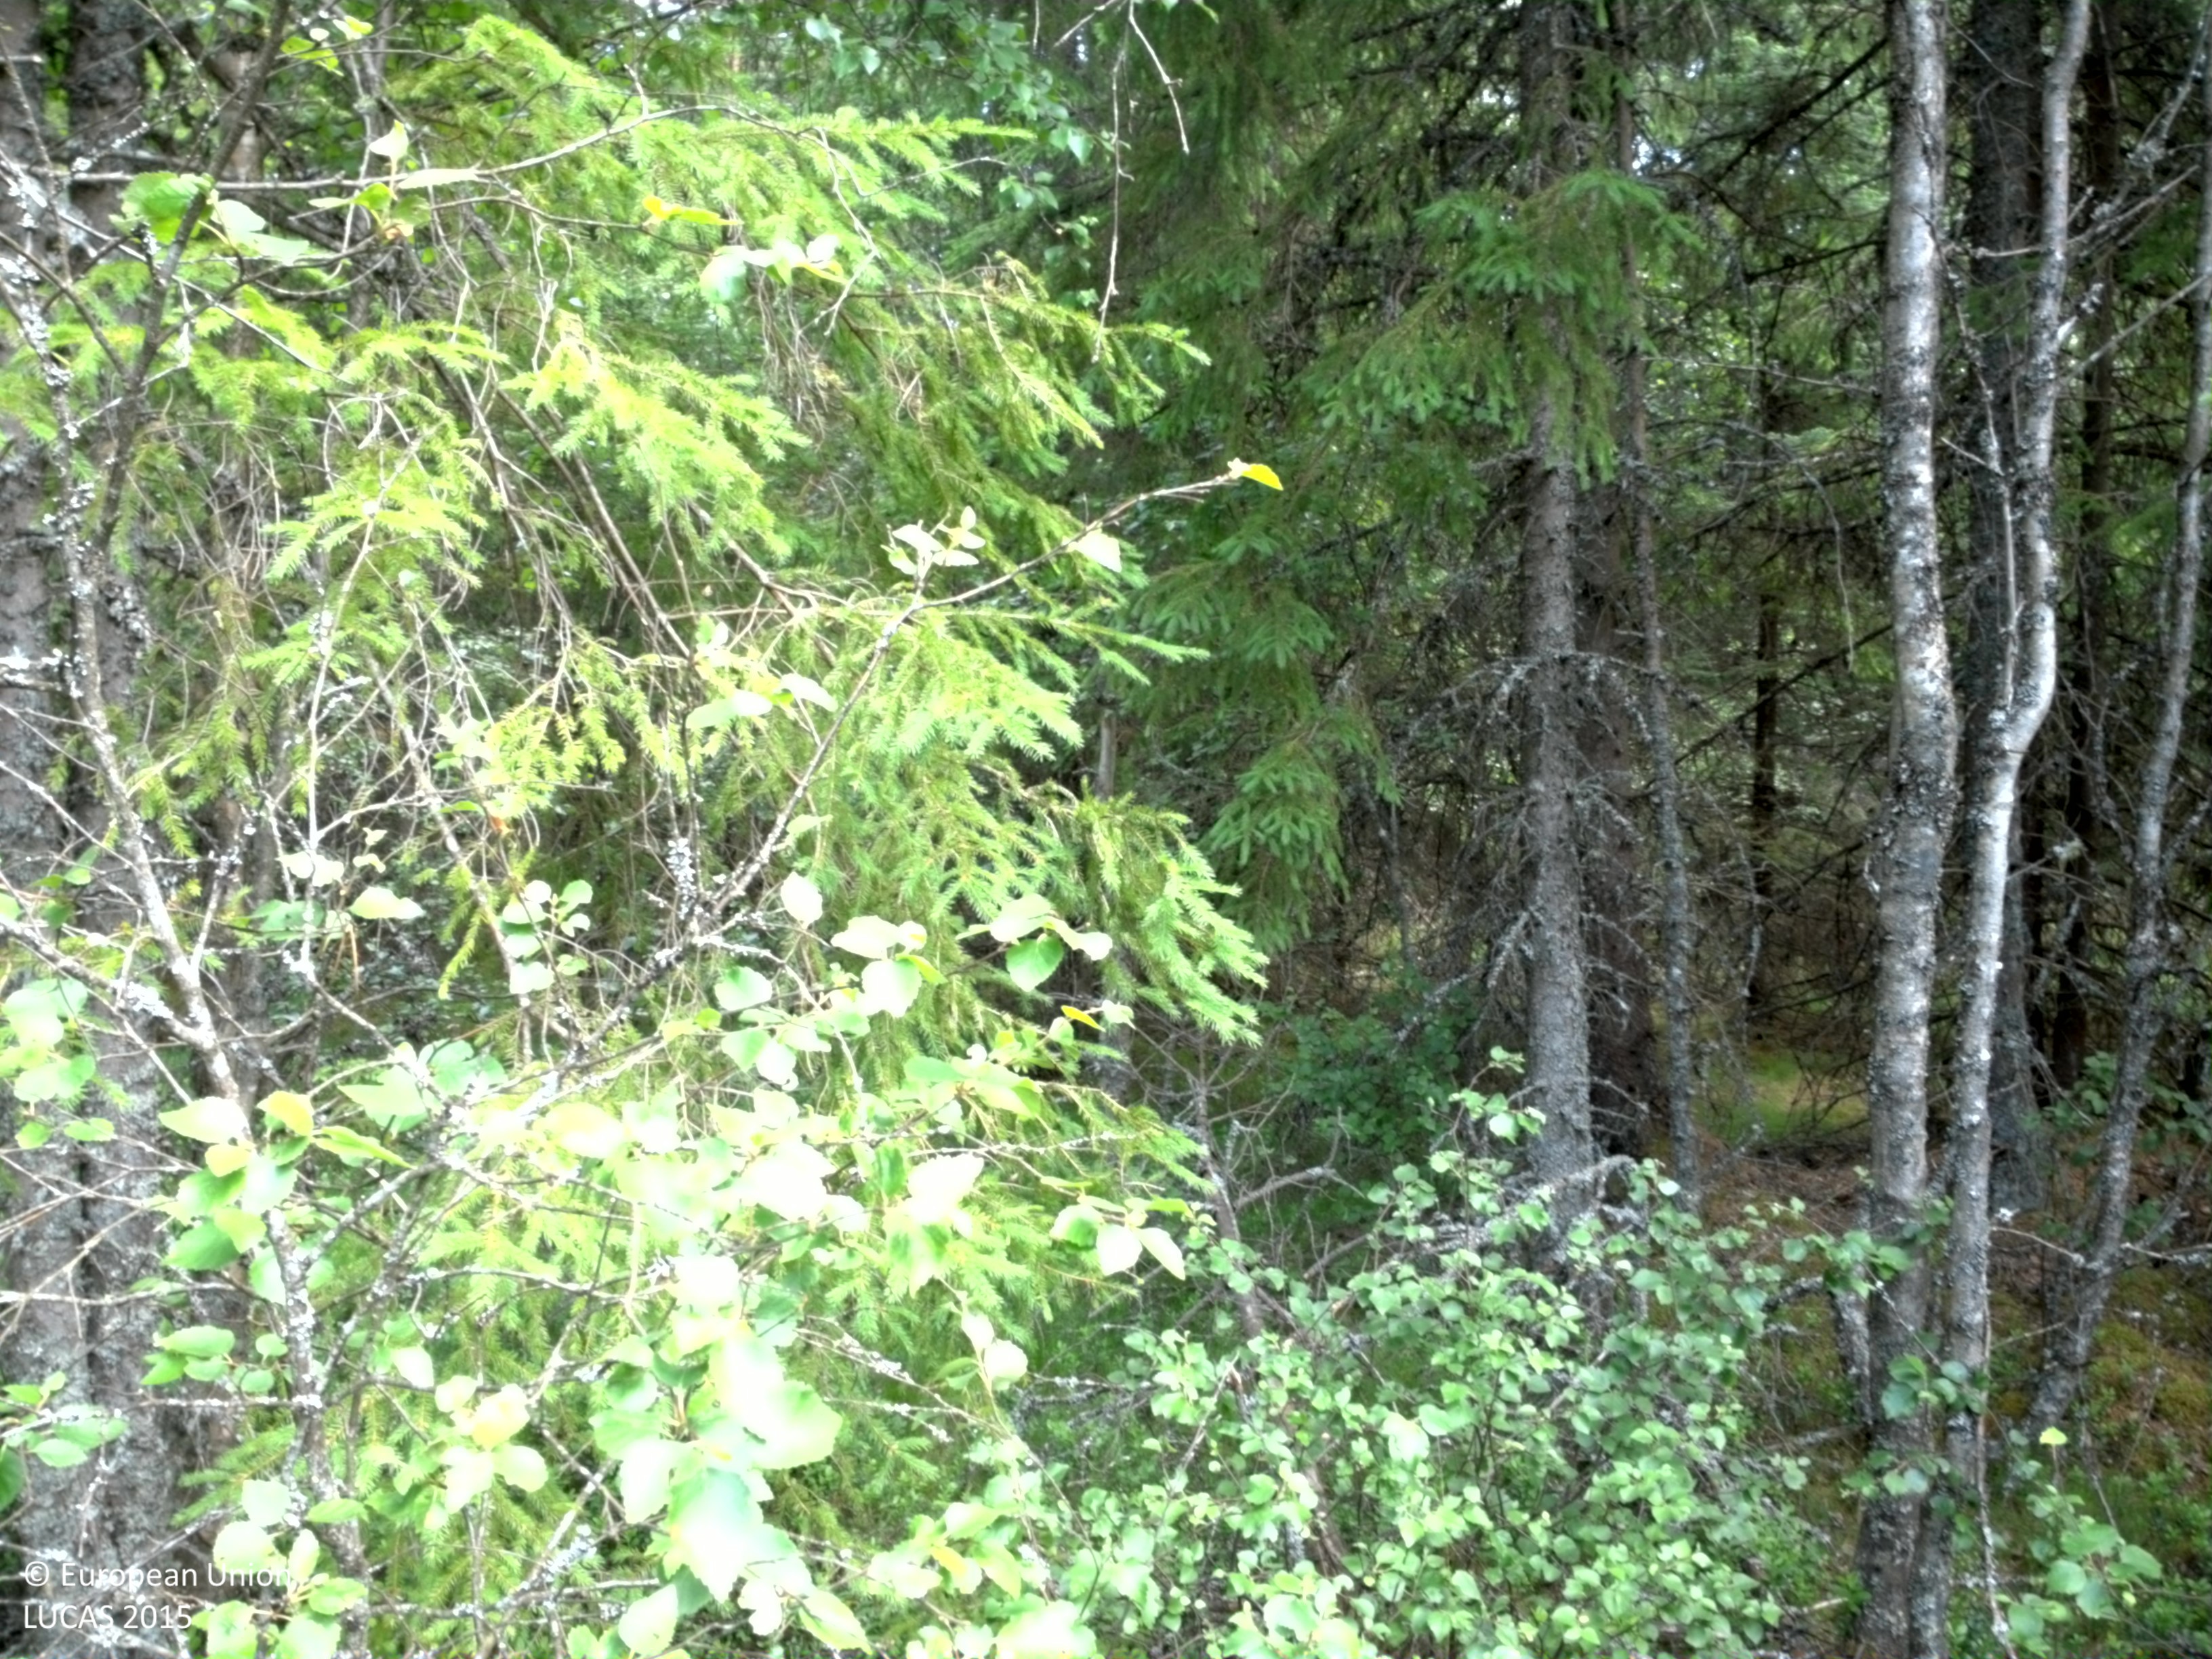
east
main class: Woodland
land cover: Spruce dominated mixed woodland
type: boreal forest
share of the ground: 50 - 75 %
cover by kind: coniferous forest trees 40 %, broadleaved forest trees 35 %, shrubs 20 %, herbaceous plants 5 %
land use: Forestry
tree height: > 5 m
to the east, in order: Spruce dominated mixed woodland; Spruce dominated coniferous woodland; Ditches and canals; Pine dominated mixed woodland; Pine dominated coniferous woodland; Paved roads, cycling and walking lanes; Pine dominated coniferous woodland
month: July
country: SE
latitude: 57.6597
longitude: 13.8669
